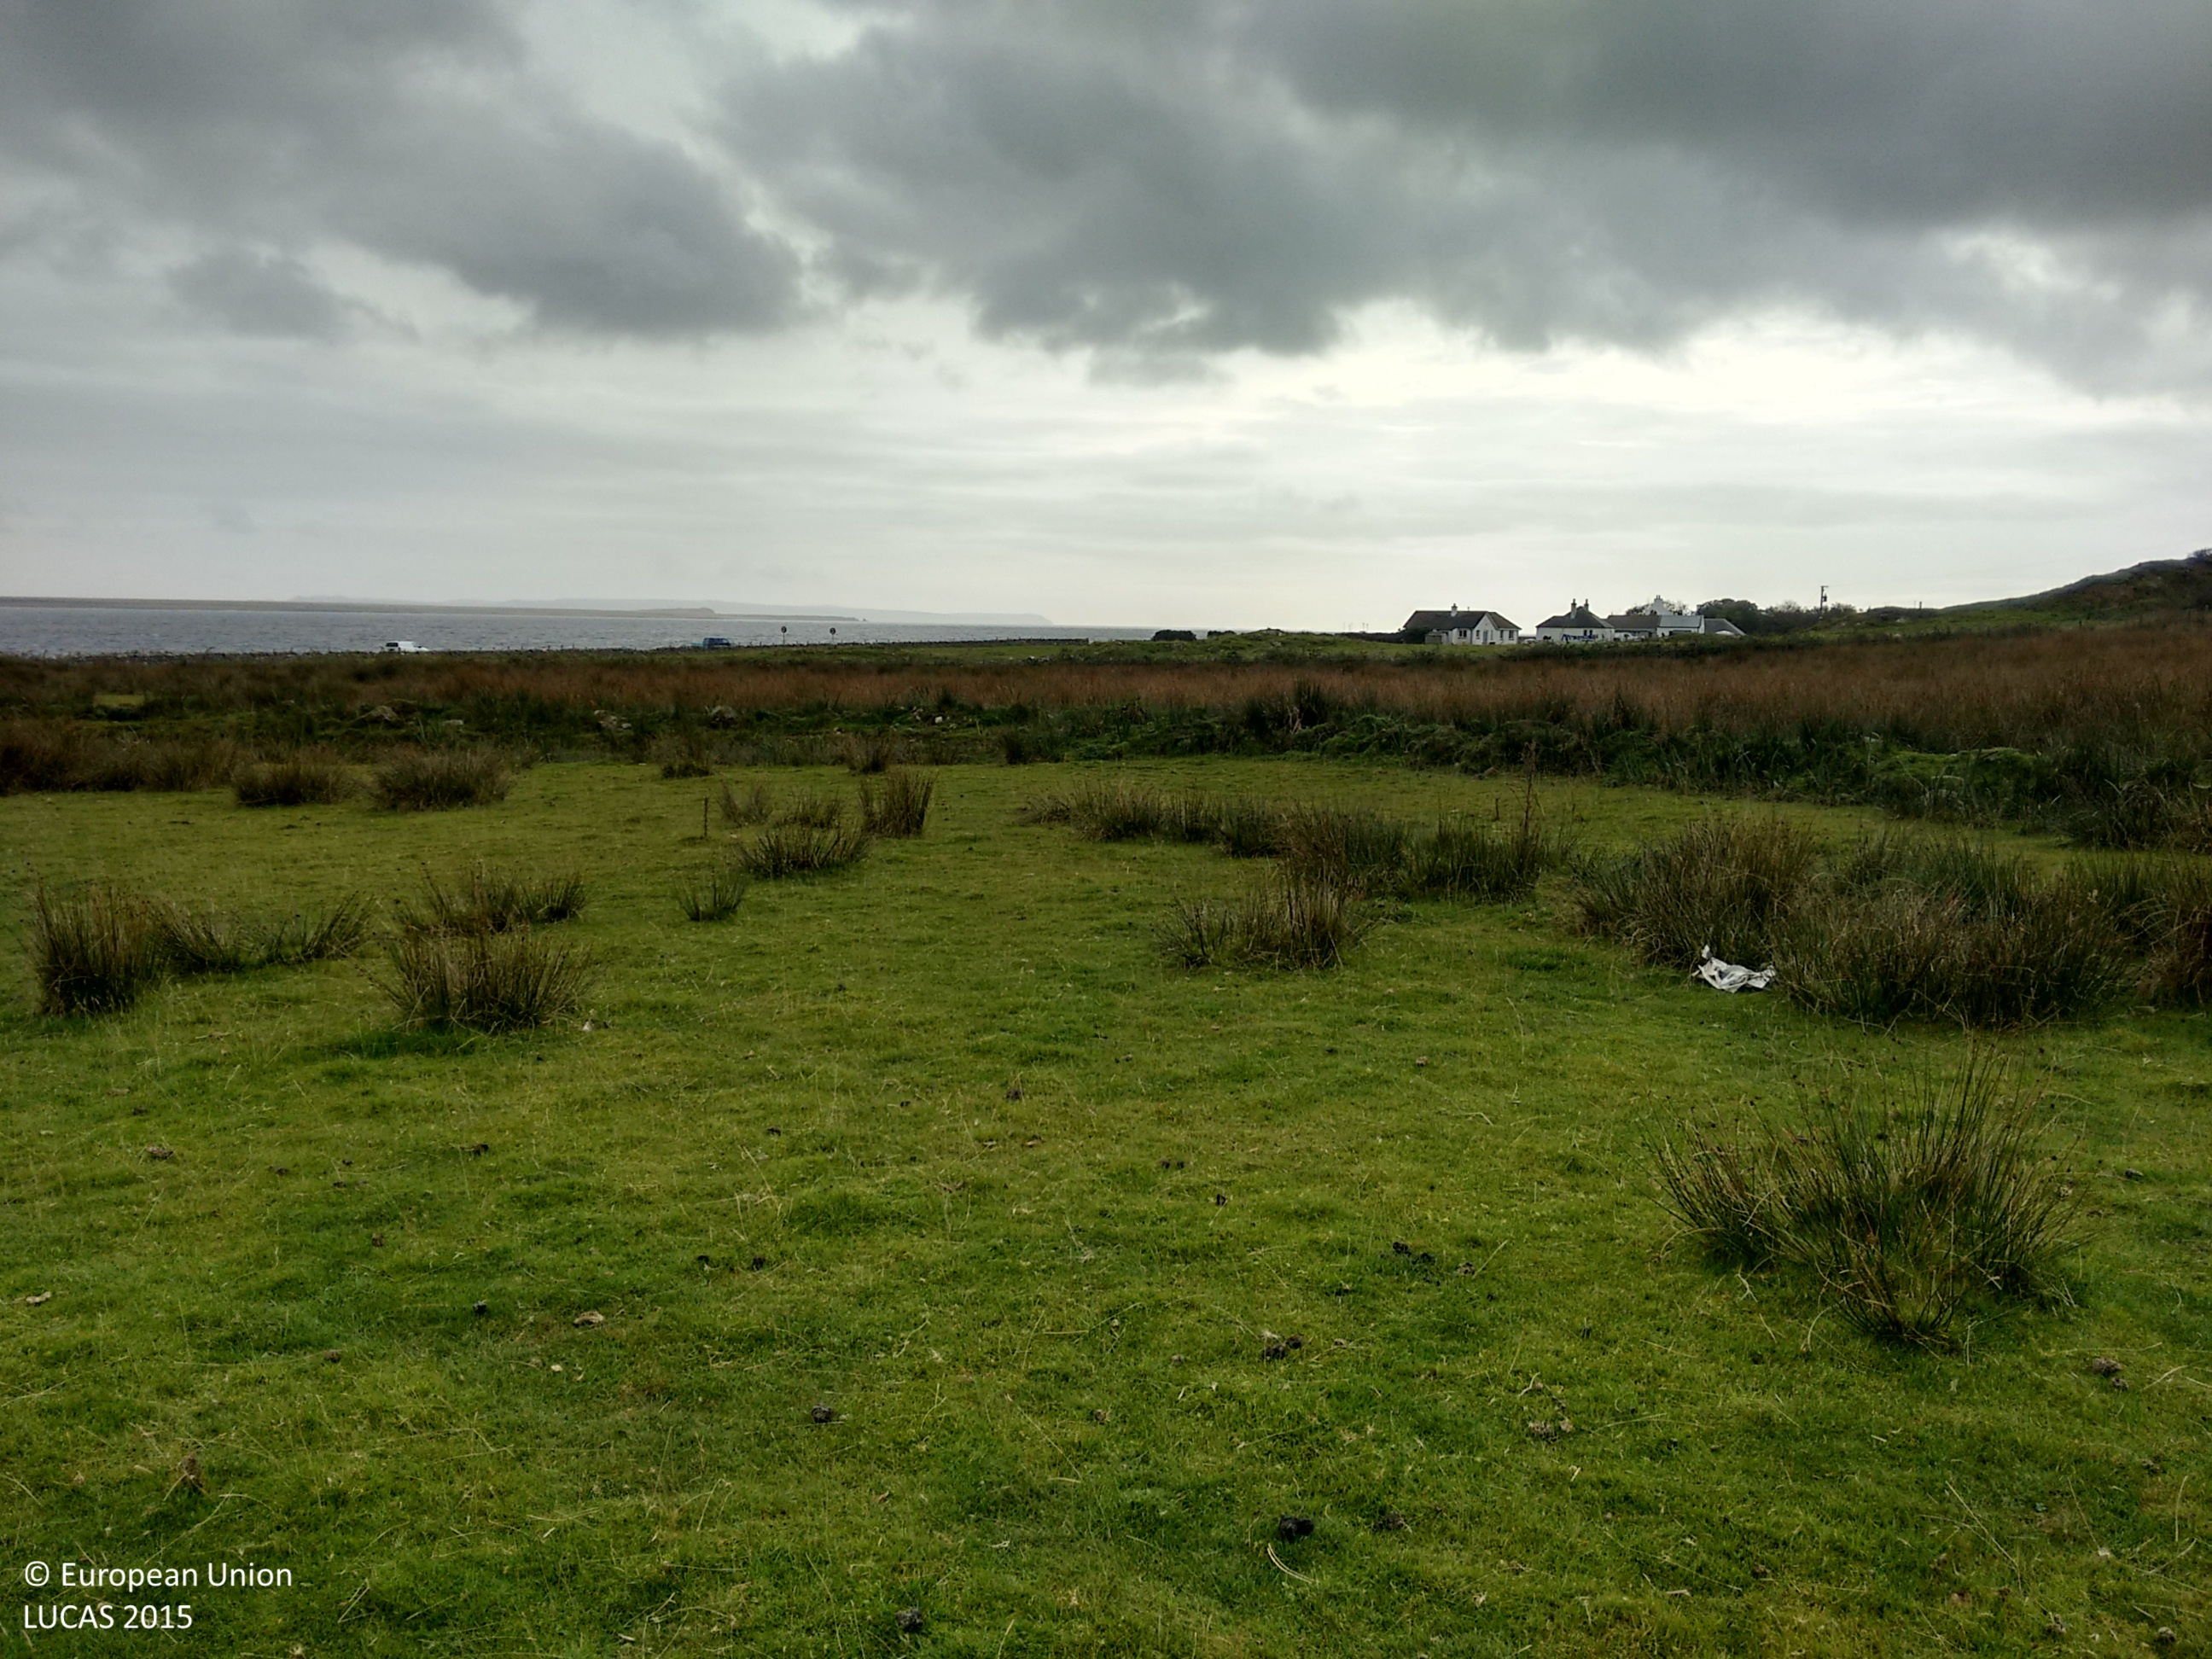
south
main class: Grassland
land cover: Grassland without tree/shrub cover
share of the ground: > 75 %
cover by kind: herbaceous plants 100 %
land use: Agriculture (excluding fallow land and kitchen gardens)
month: October
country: GB
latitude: 55.7709
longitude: -6.3584
